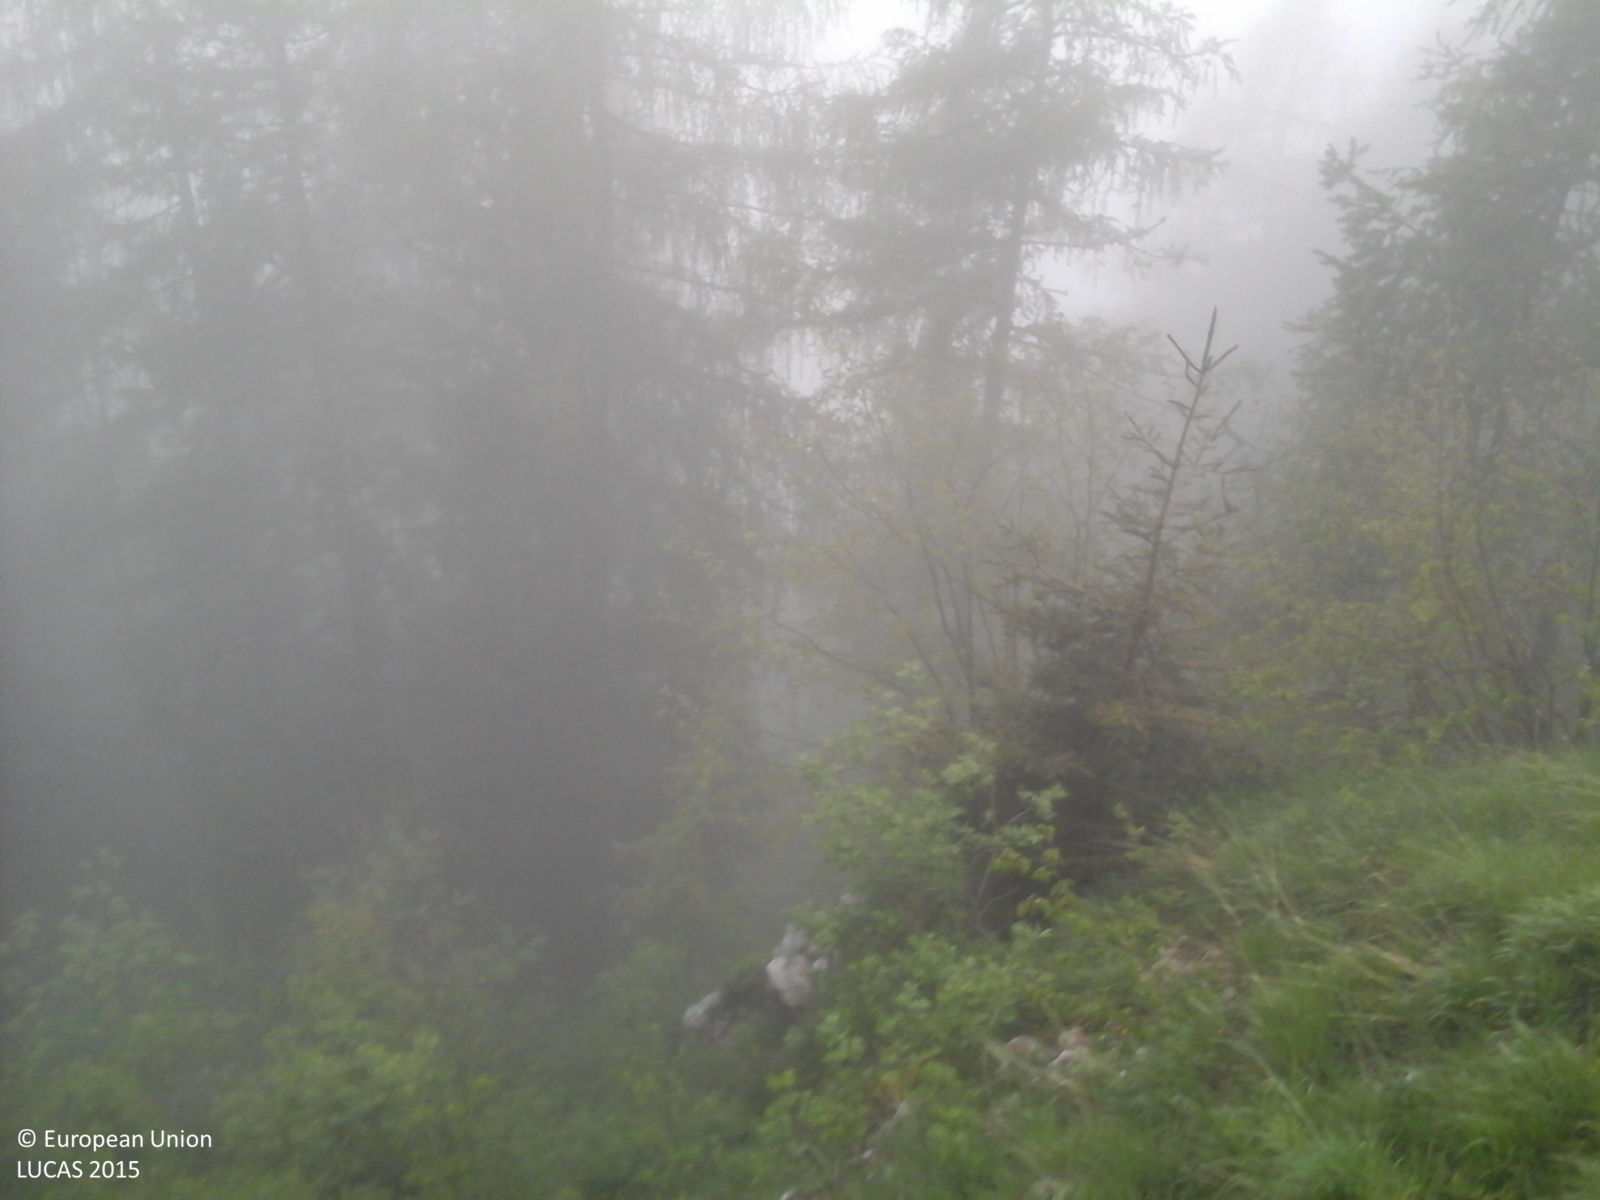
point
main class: Woodland
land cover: Other coniferous woodland
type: alpine coniferous forest
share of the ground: > 75 %
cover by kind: coniferous forest trees 80 %, herbaceous plants 20 %
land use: Forestry
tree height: > 5 m
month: May
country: IT
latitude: 46.1044
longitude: 11.6407
